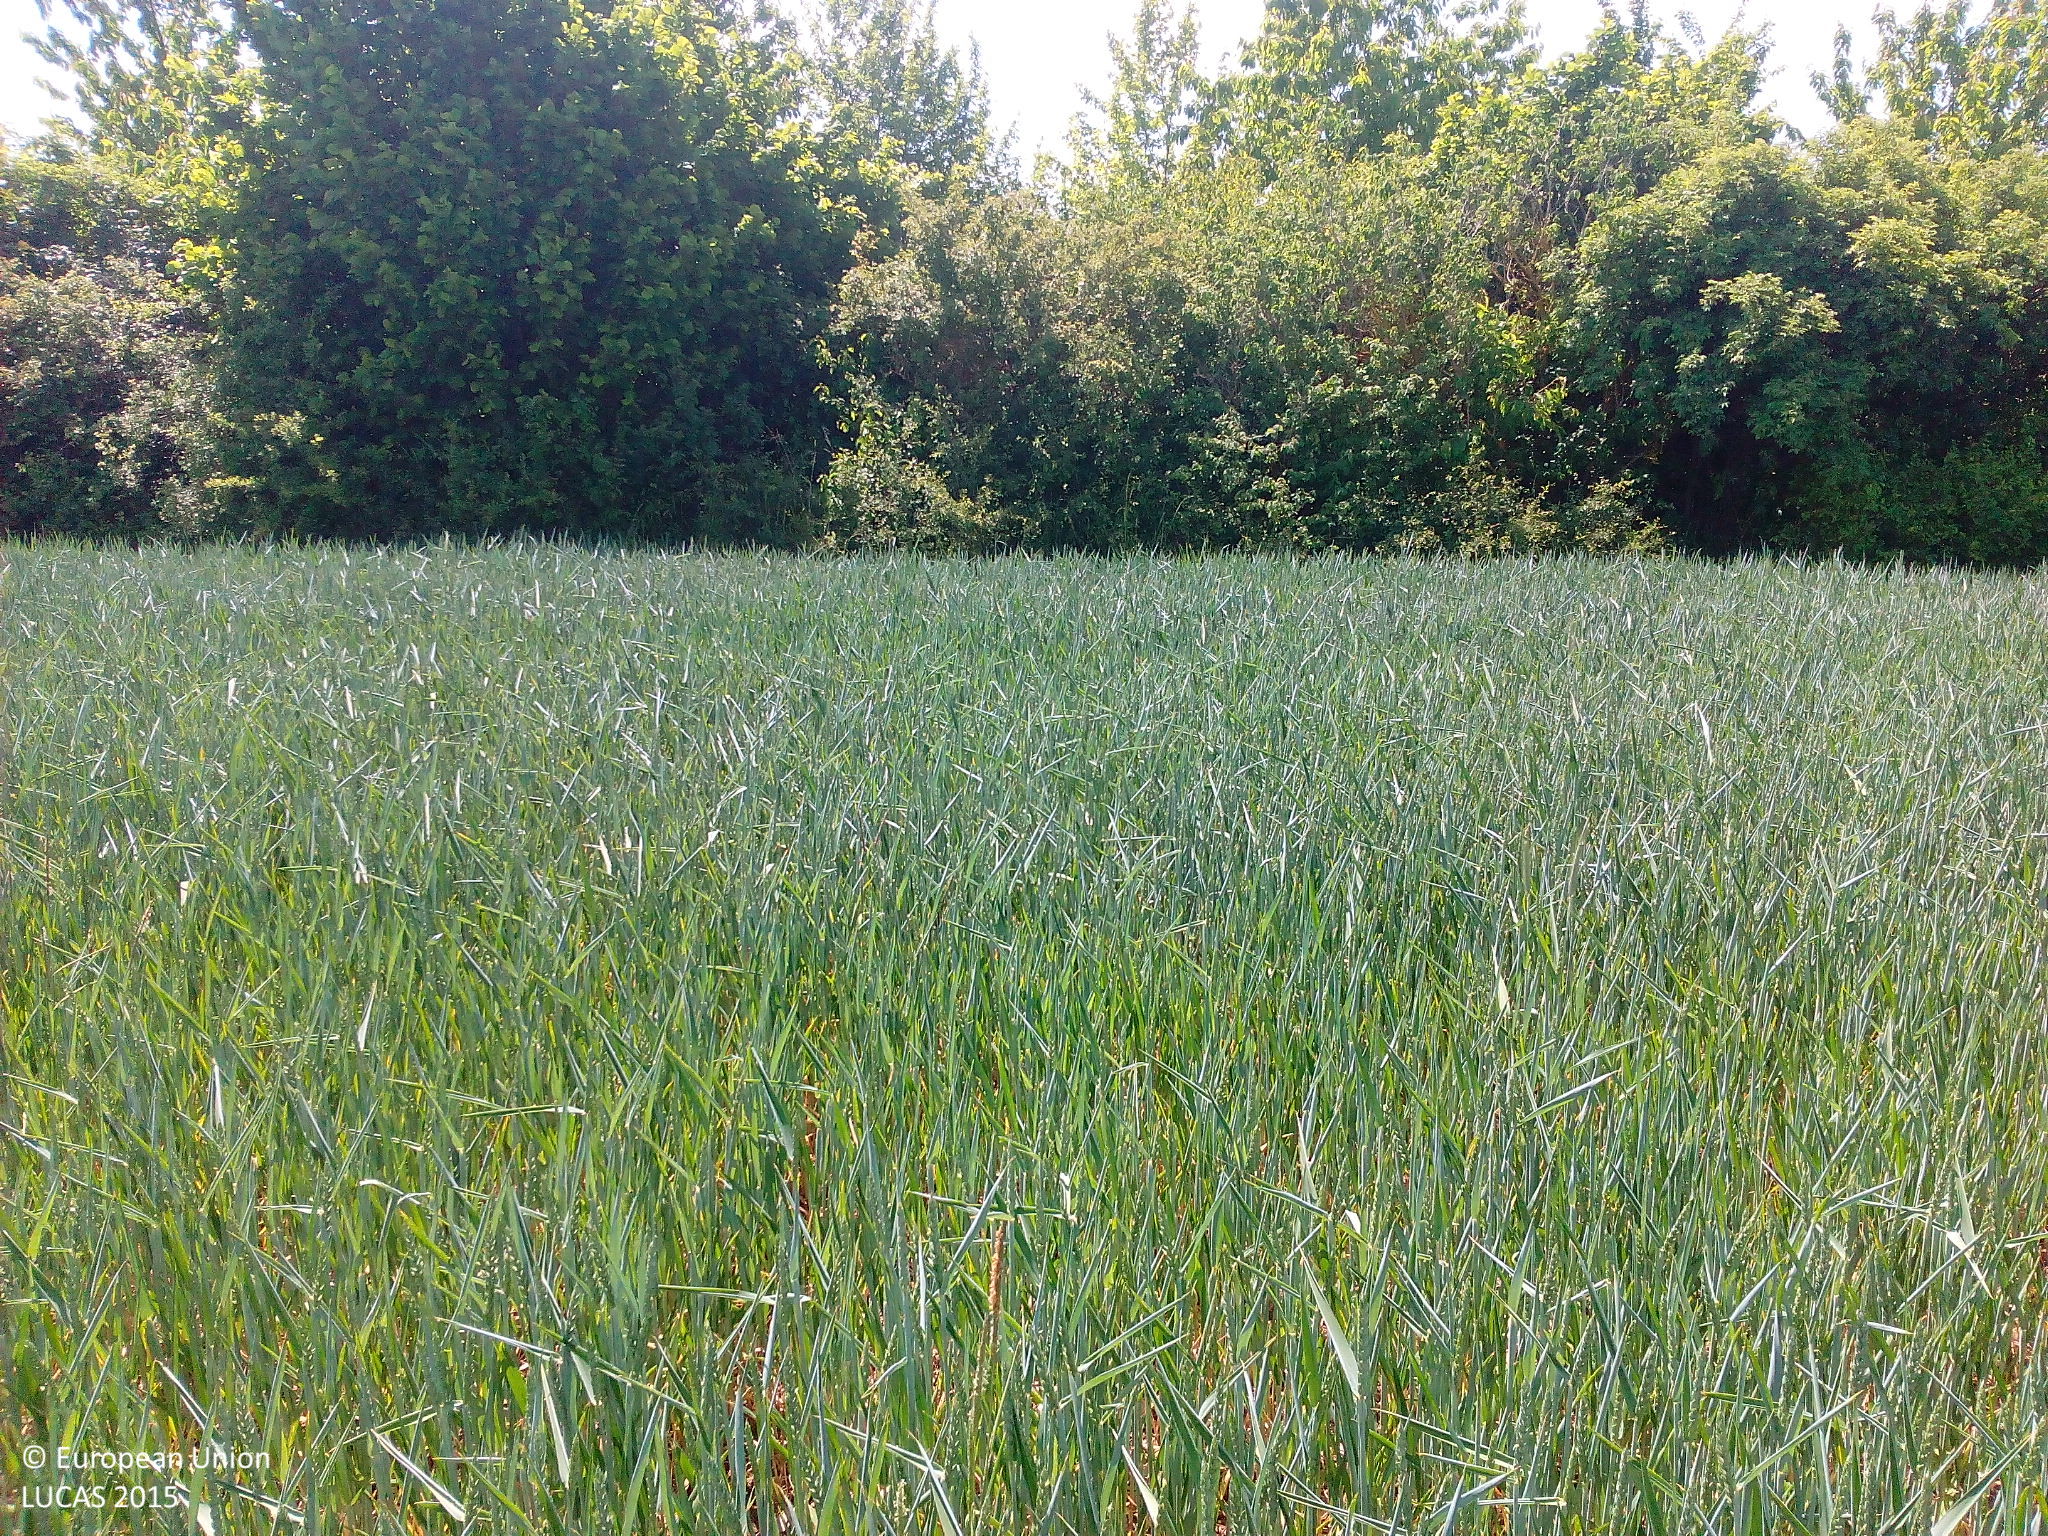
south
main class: Cropland
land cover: Common wheat
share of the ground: > 75 %
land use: Agriculture (excluding fallow land and kitchen gardens)
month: June
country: DE
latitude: 51.3684
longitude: 9.2389
